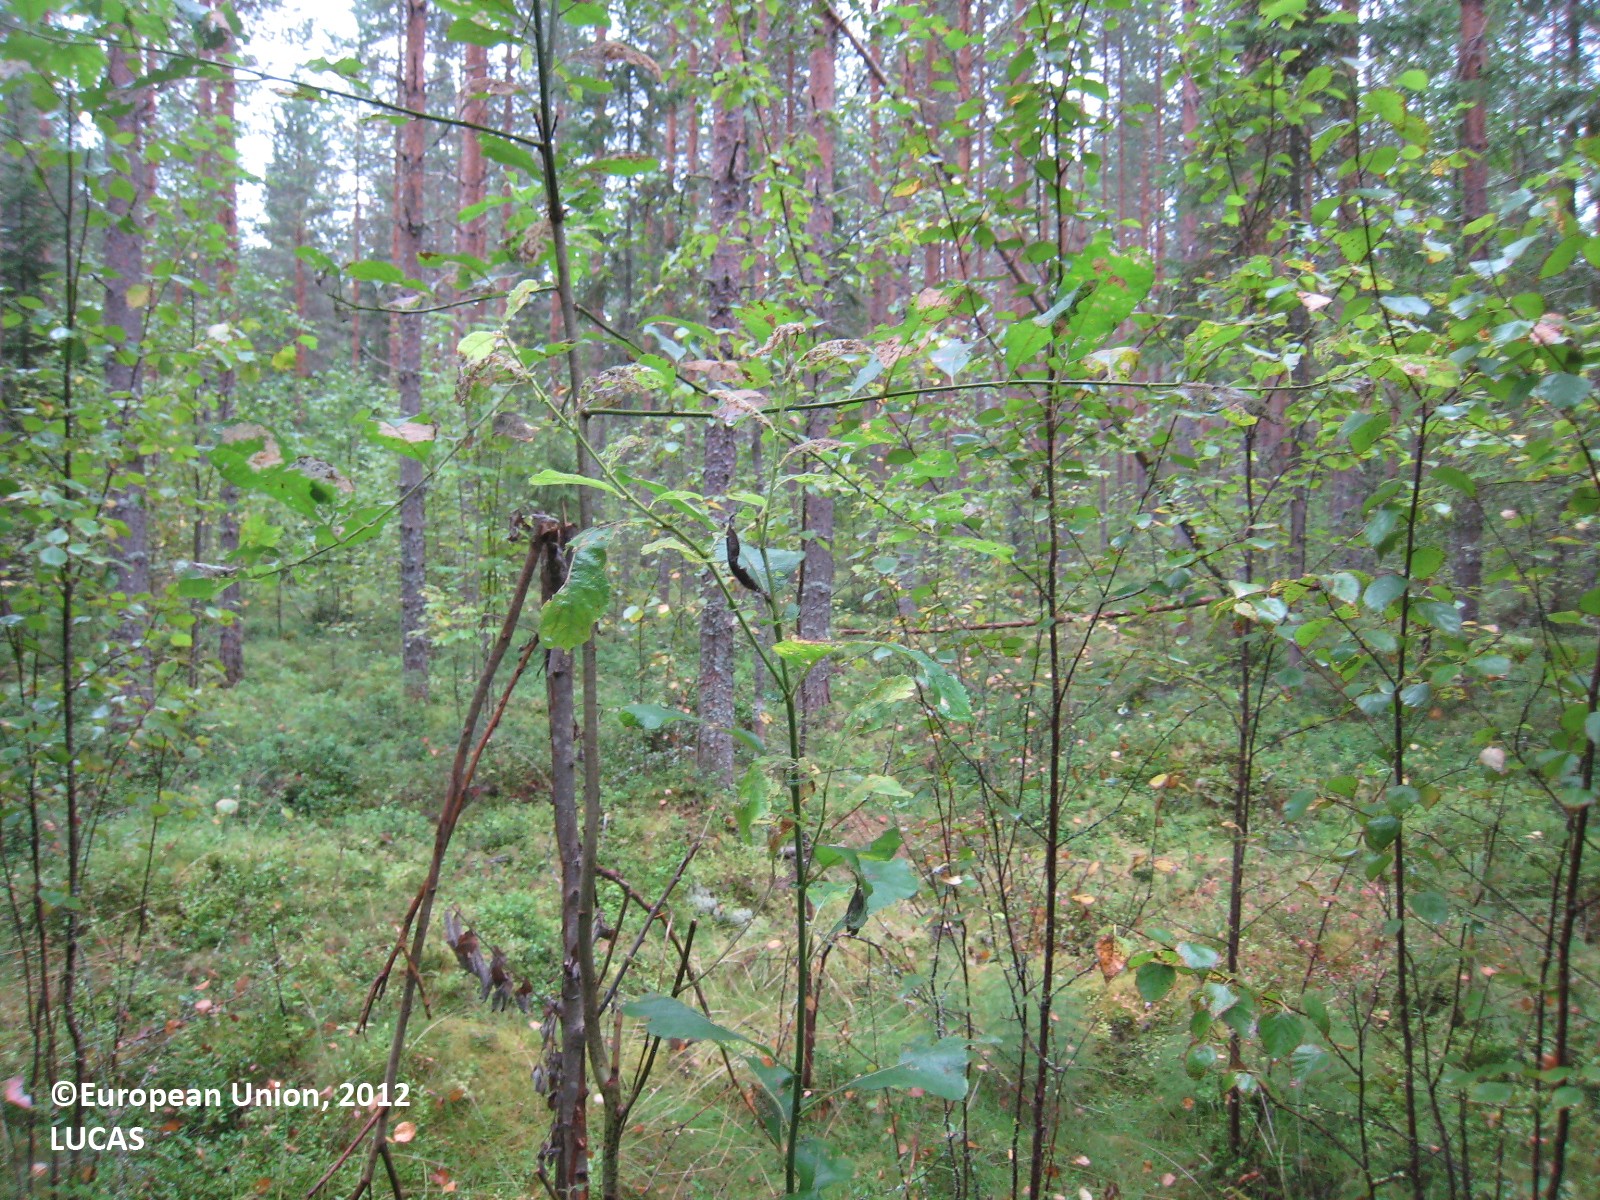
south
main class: Woodland
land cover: Other mixed woodland
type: boreal forest
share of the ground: 50 - 75 %
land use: Forestry
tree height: > 5 m
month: August
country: FI
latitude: 61.8559
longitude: 26.1941
